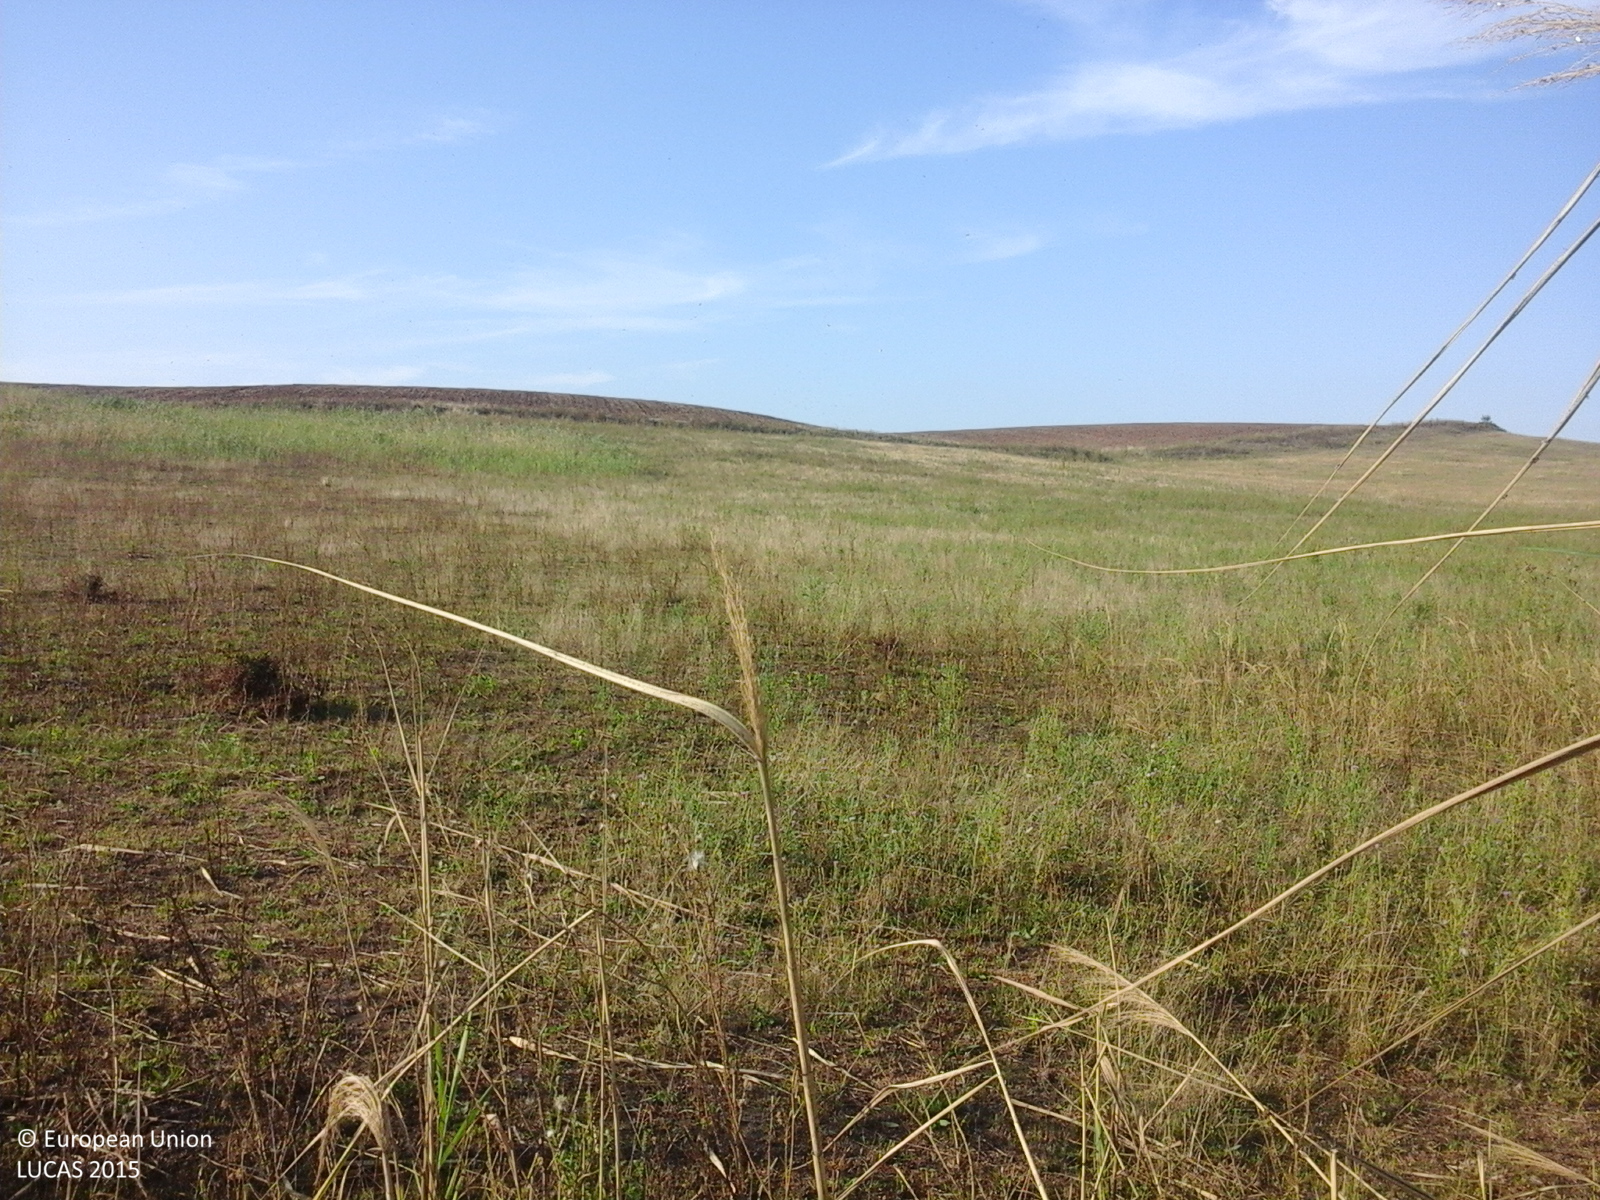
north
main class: Grassland
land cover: Spontaneously vegetated surfaces
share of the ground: > 75 %
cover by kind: herbaceous plants 100 %
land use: Fallow land
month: August
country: RO
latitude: 46.0533
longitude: 21.1858
